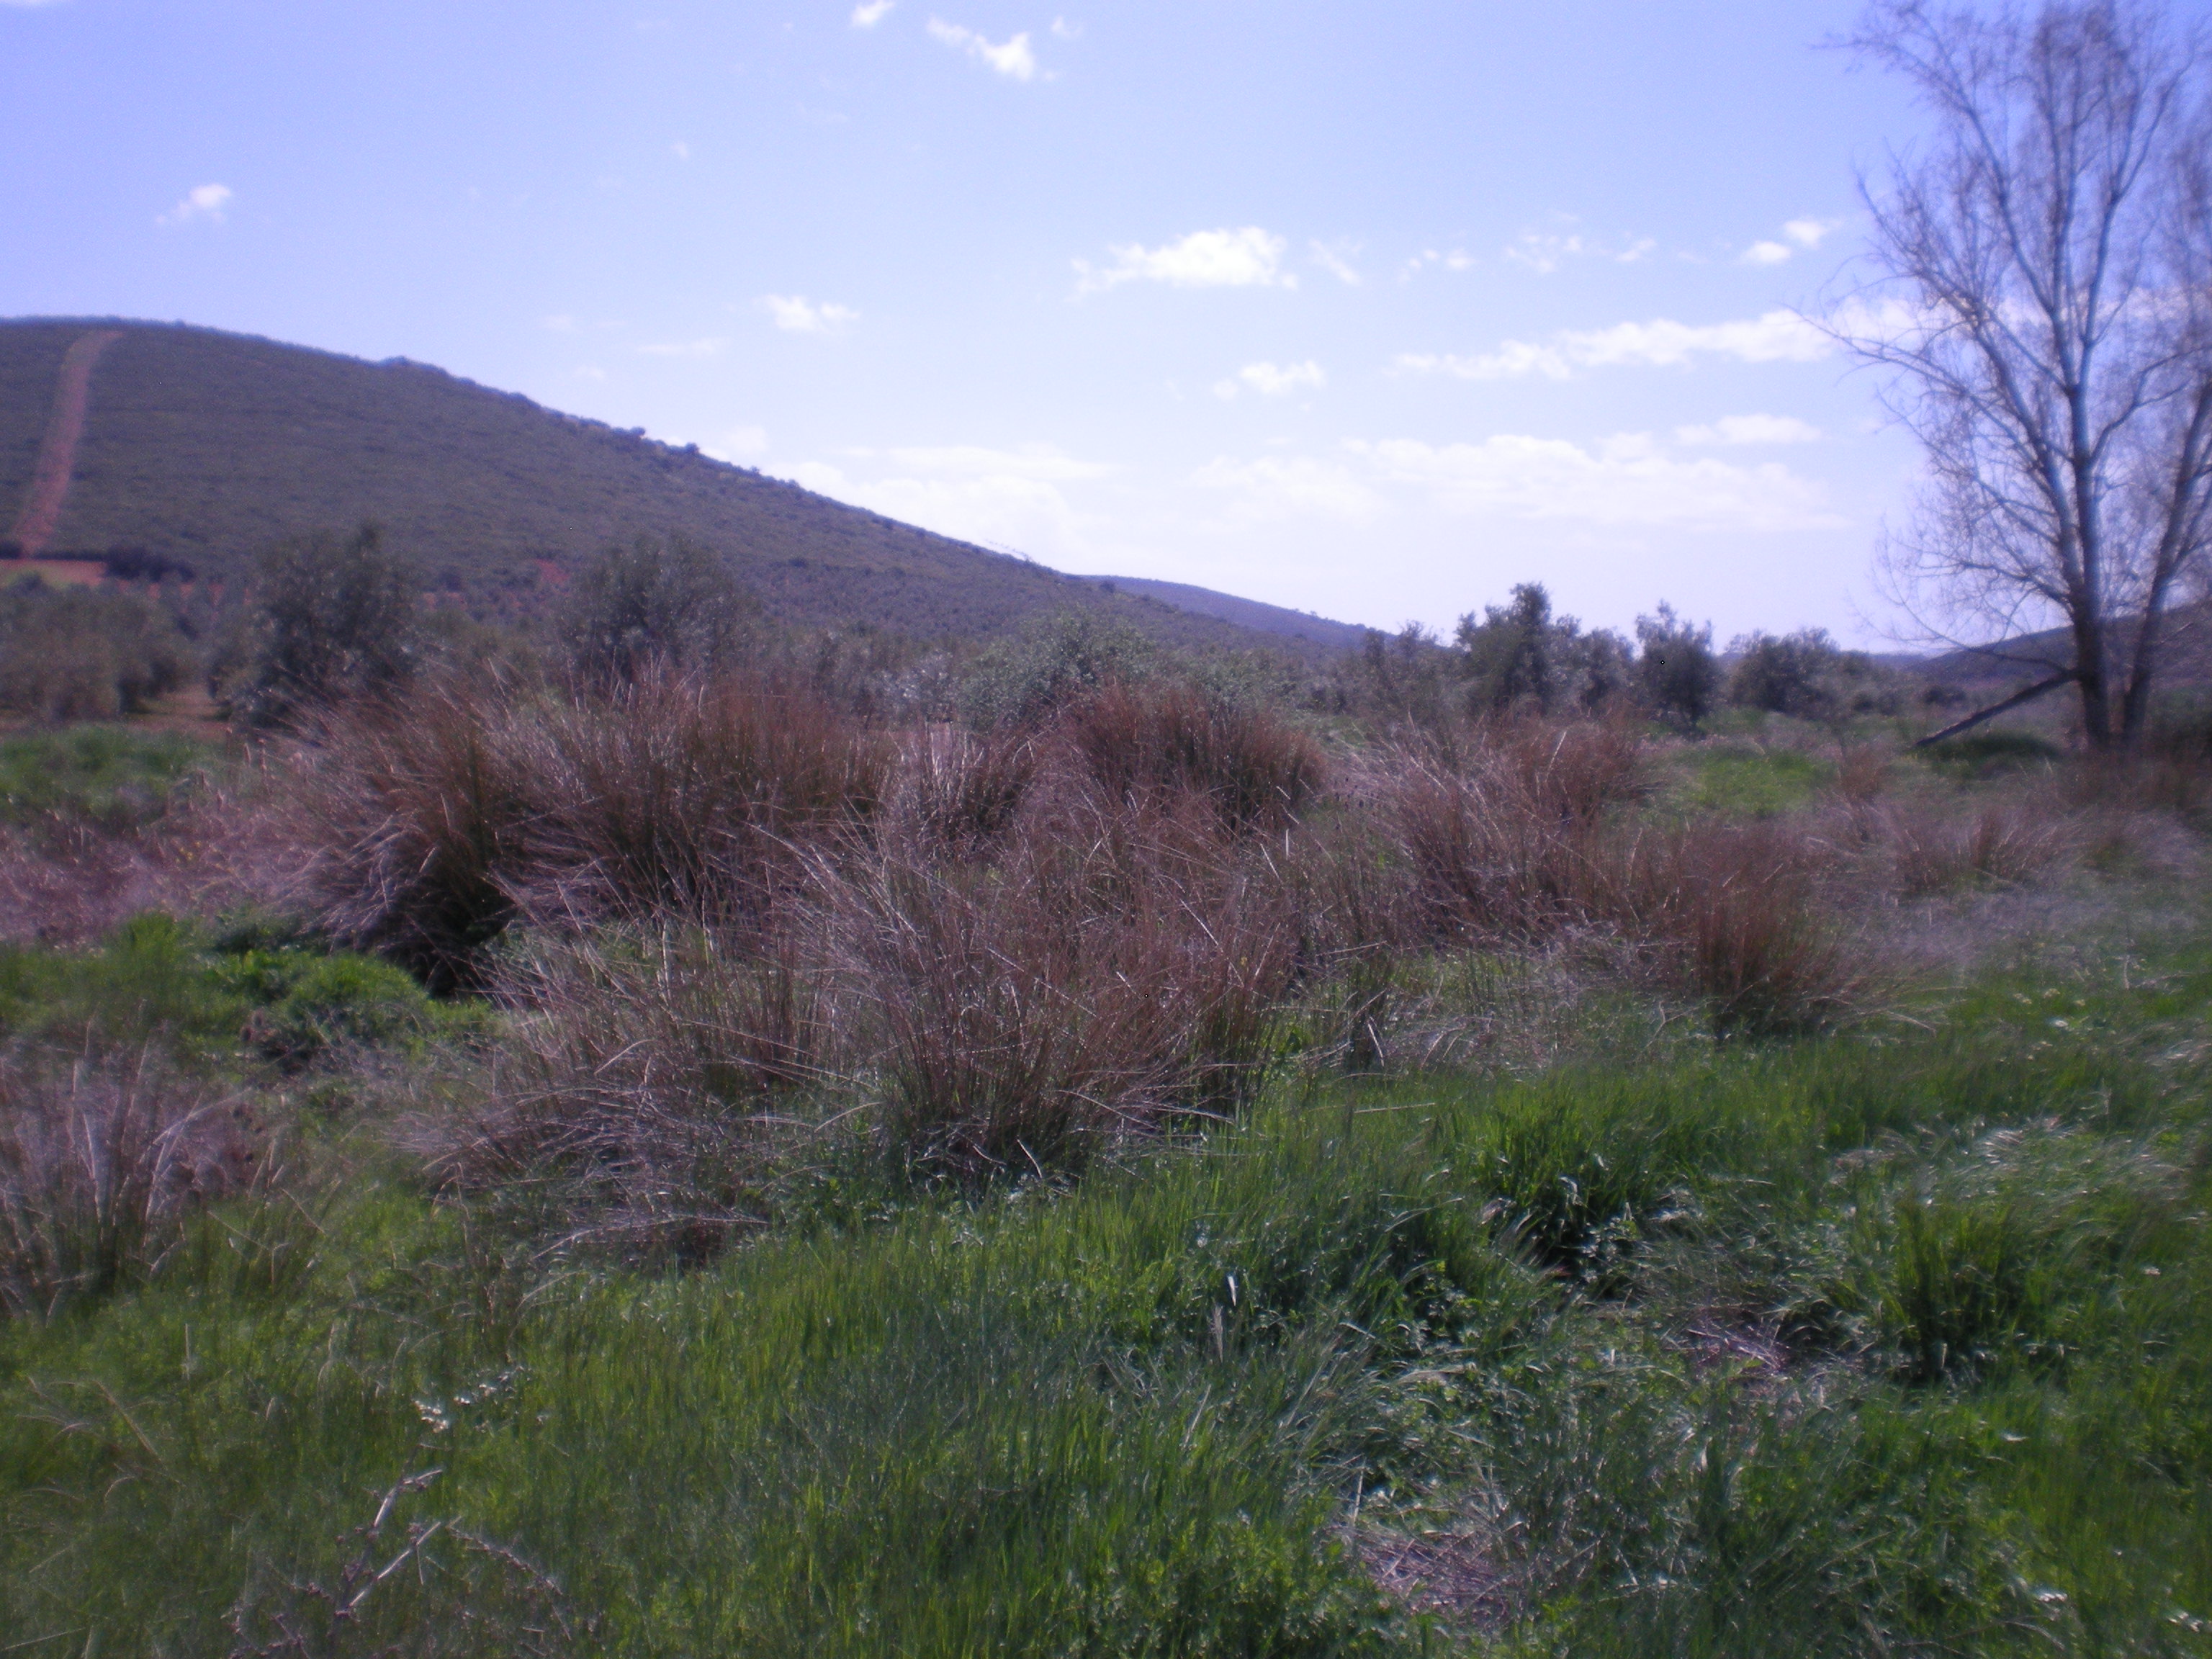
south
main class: Grassland
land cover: Grassland without tree/shrub cover
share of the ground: > 75 %
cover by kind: herbaceous plants 100 %
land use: Semi-natural and natural areas not in use
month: April
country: ES
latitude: 38.5900
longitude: -3.5460
